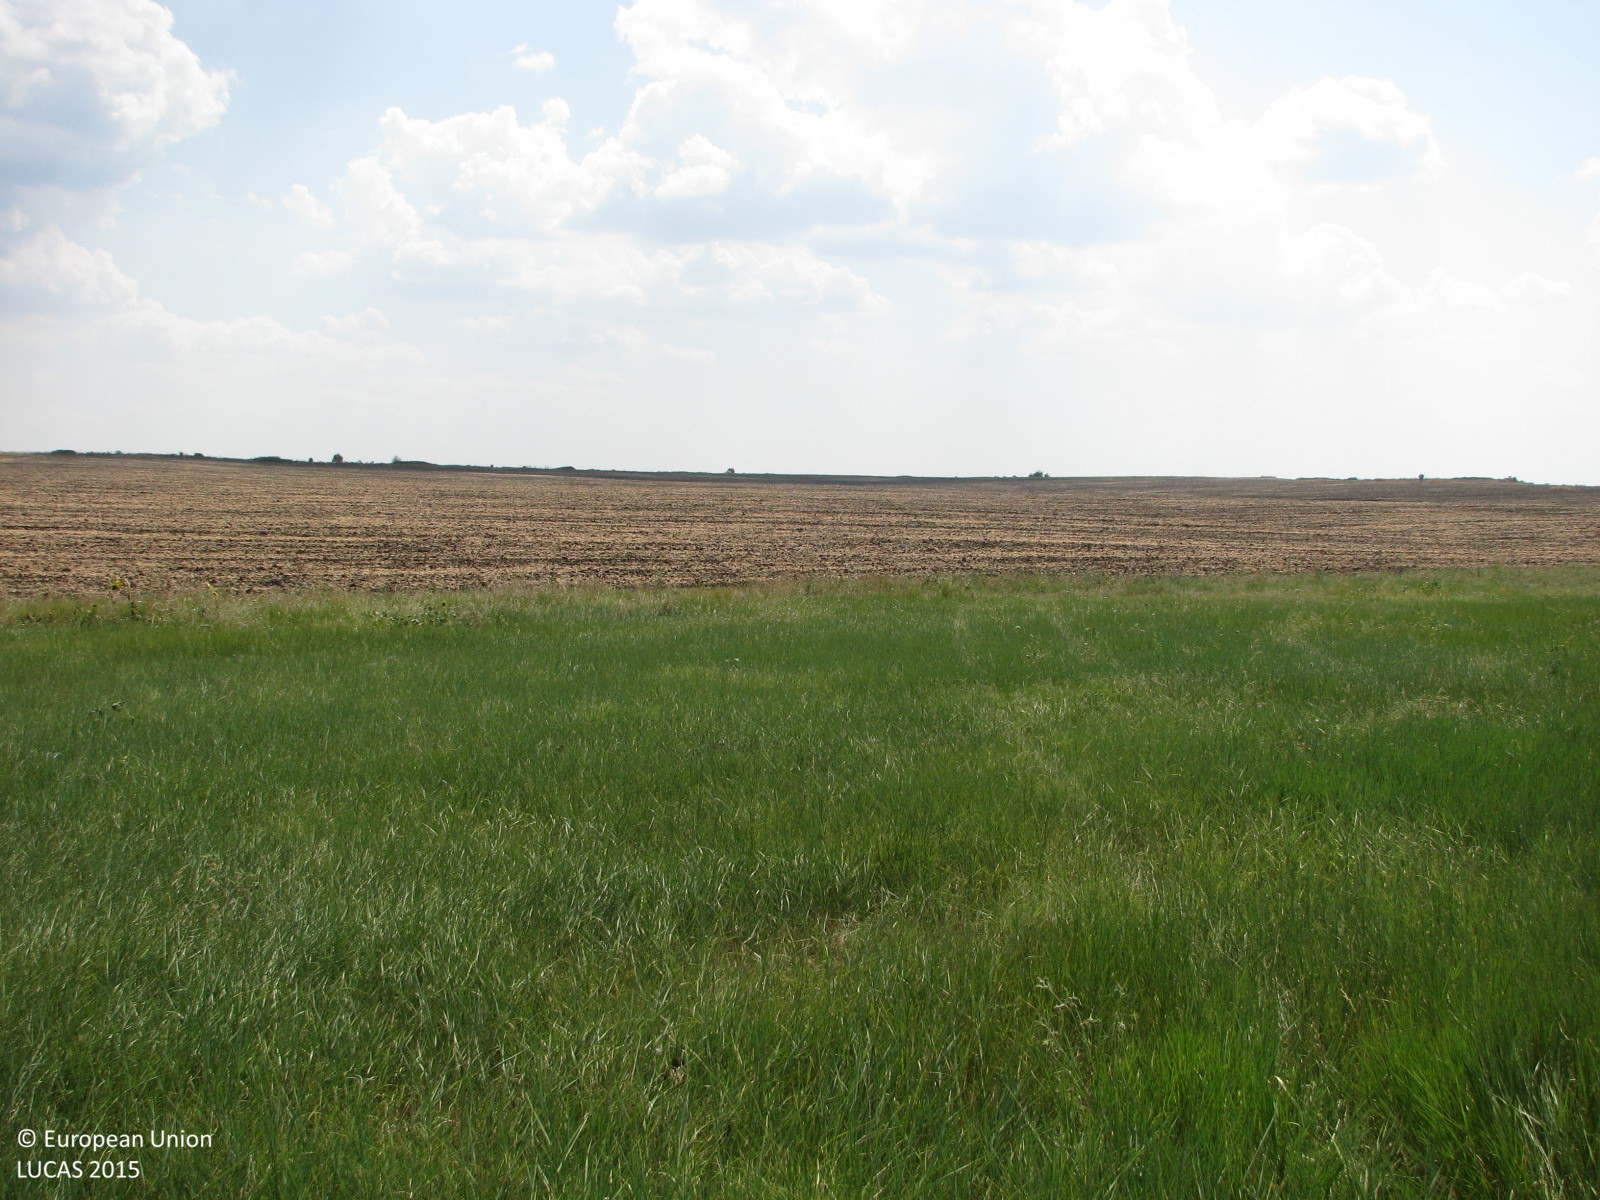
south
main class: Grassland
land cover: Grassland without tree/shrub cover
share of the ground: > 75 %
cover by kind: herbaceous plants 100 %
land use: Agriculture (excluding fallow land and kitchen gardens)
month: August
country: BG
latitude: 42.1482
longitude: 26.7568
